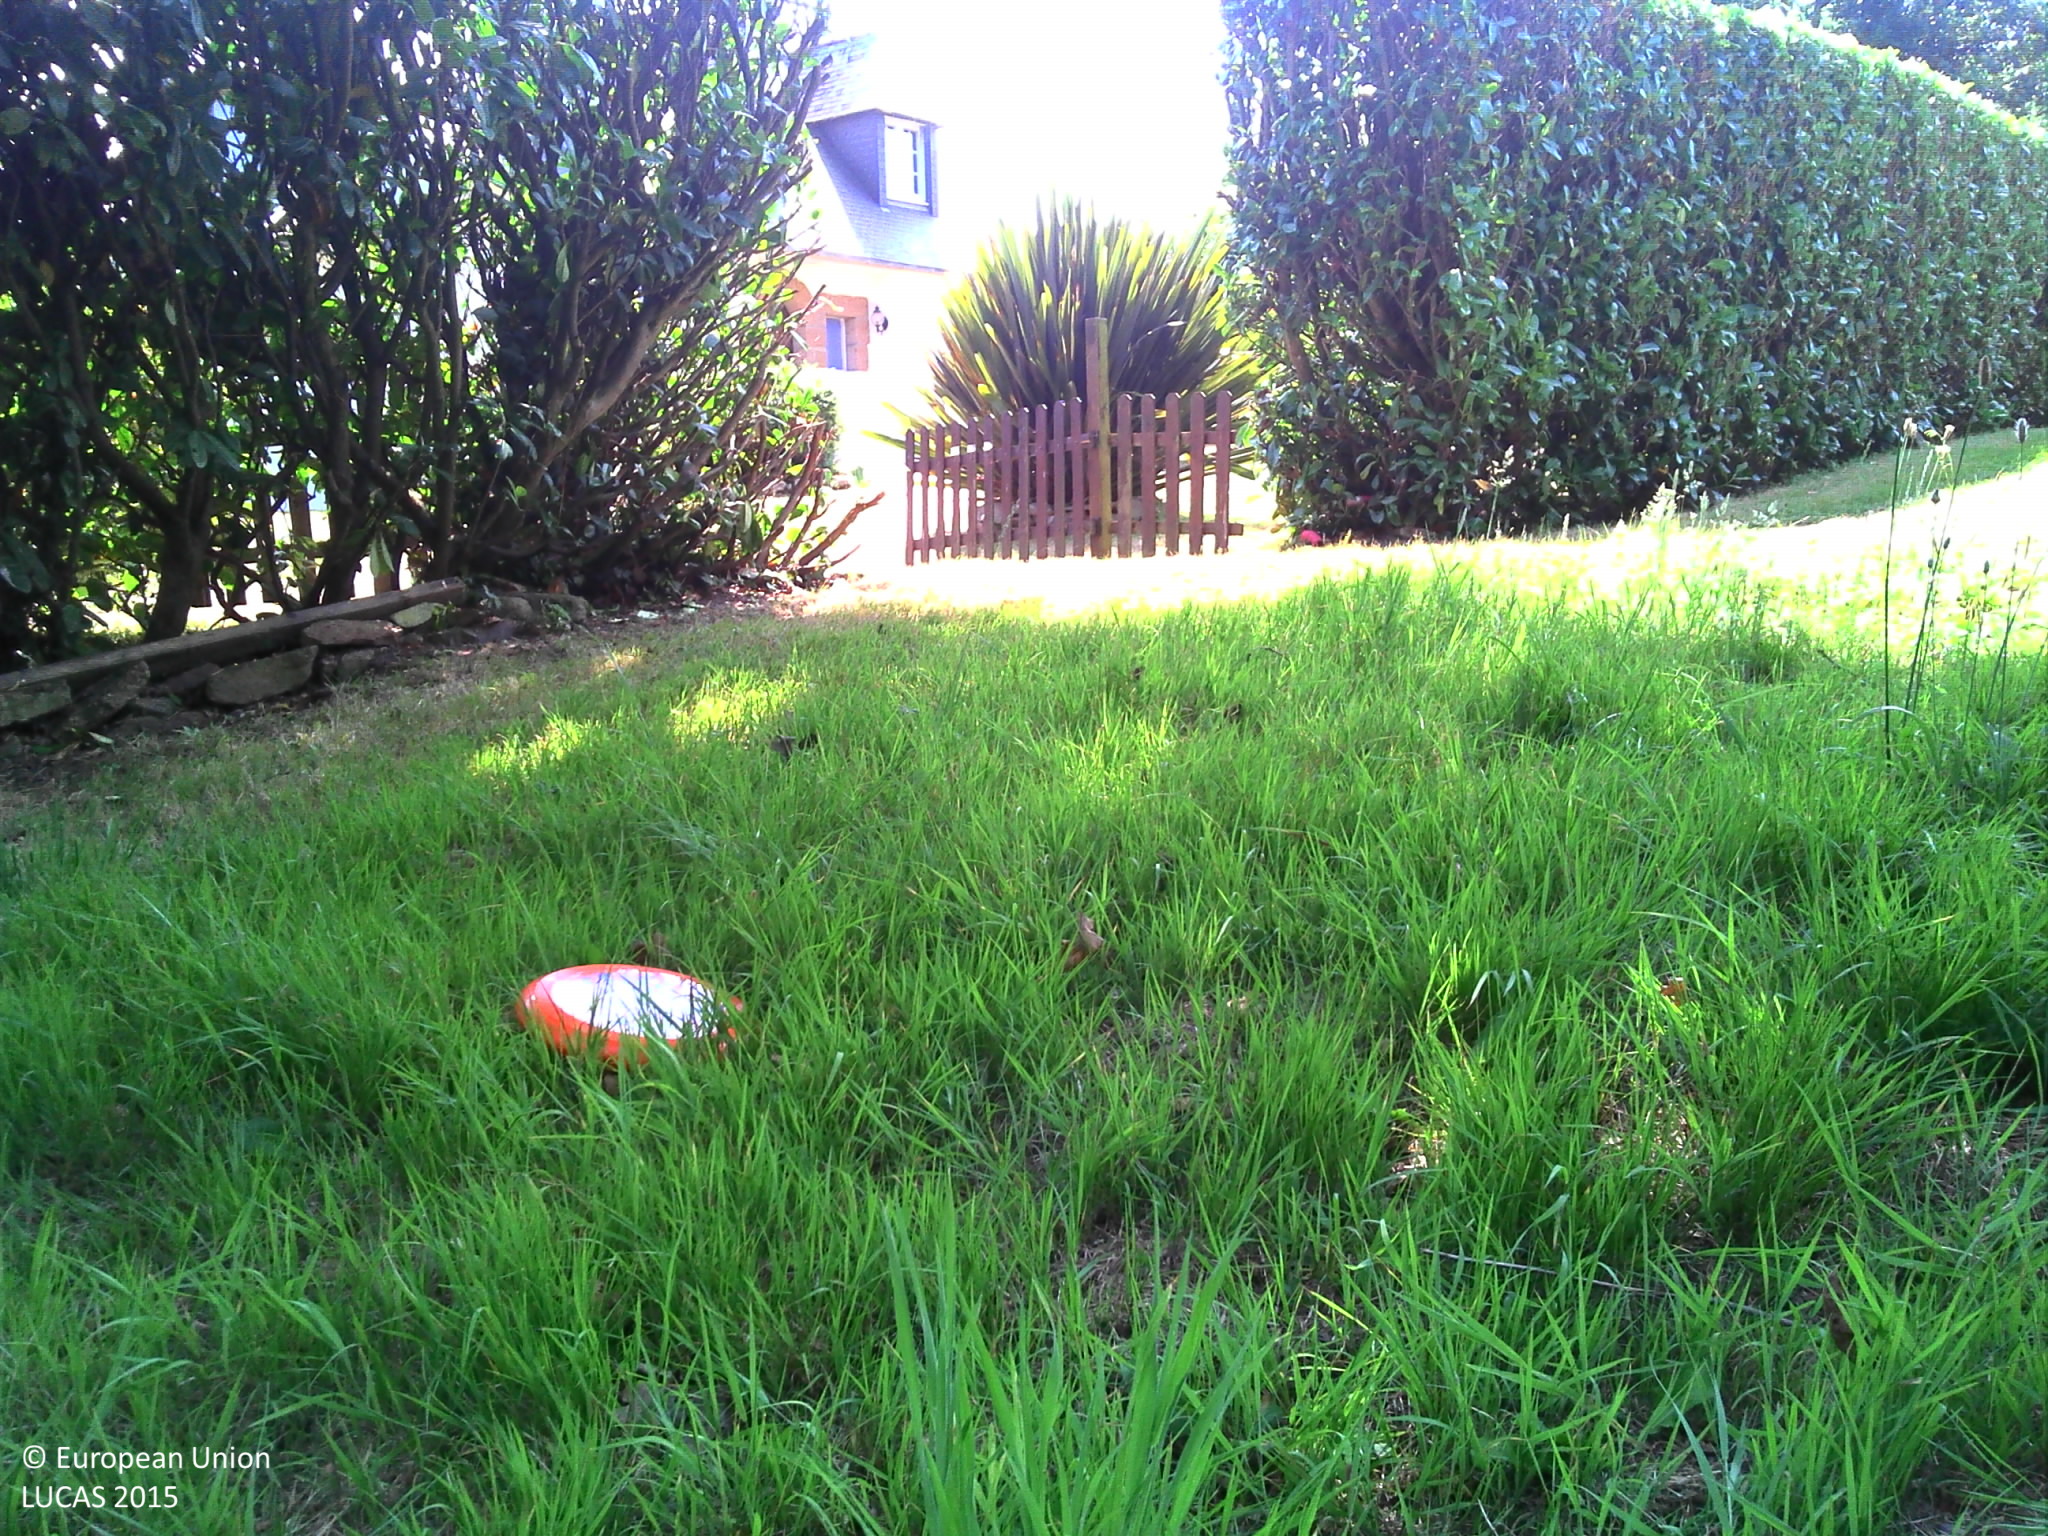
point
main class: Grassland
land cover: Grassland with sparse tree/shrub cover
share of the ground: > 75 %
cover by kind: herbaceous plants 80 %, unconsolidated bare surface 15 %, coniferous forest trees 5 %
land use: Community services
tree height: > 5 m
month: July
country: FR
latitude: 48.7845
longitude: -3.5689
